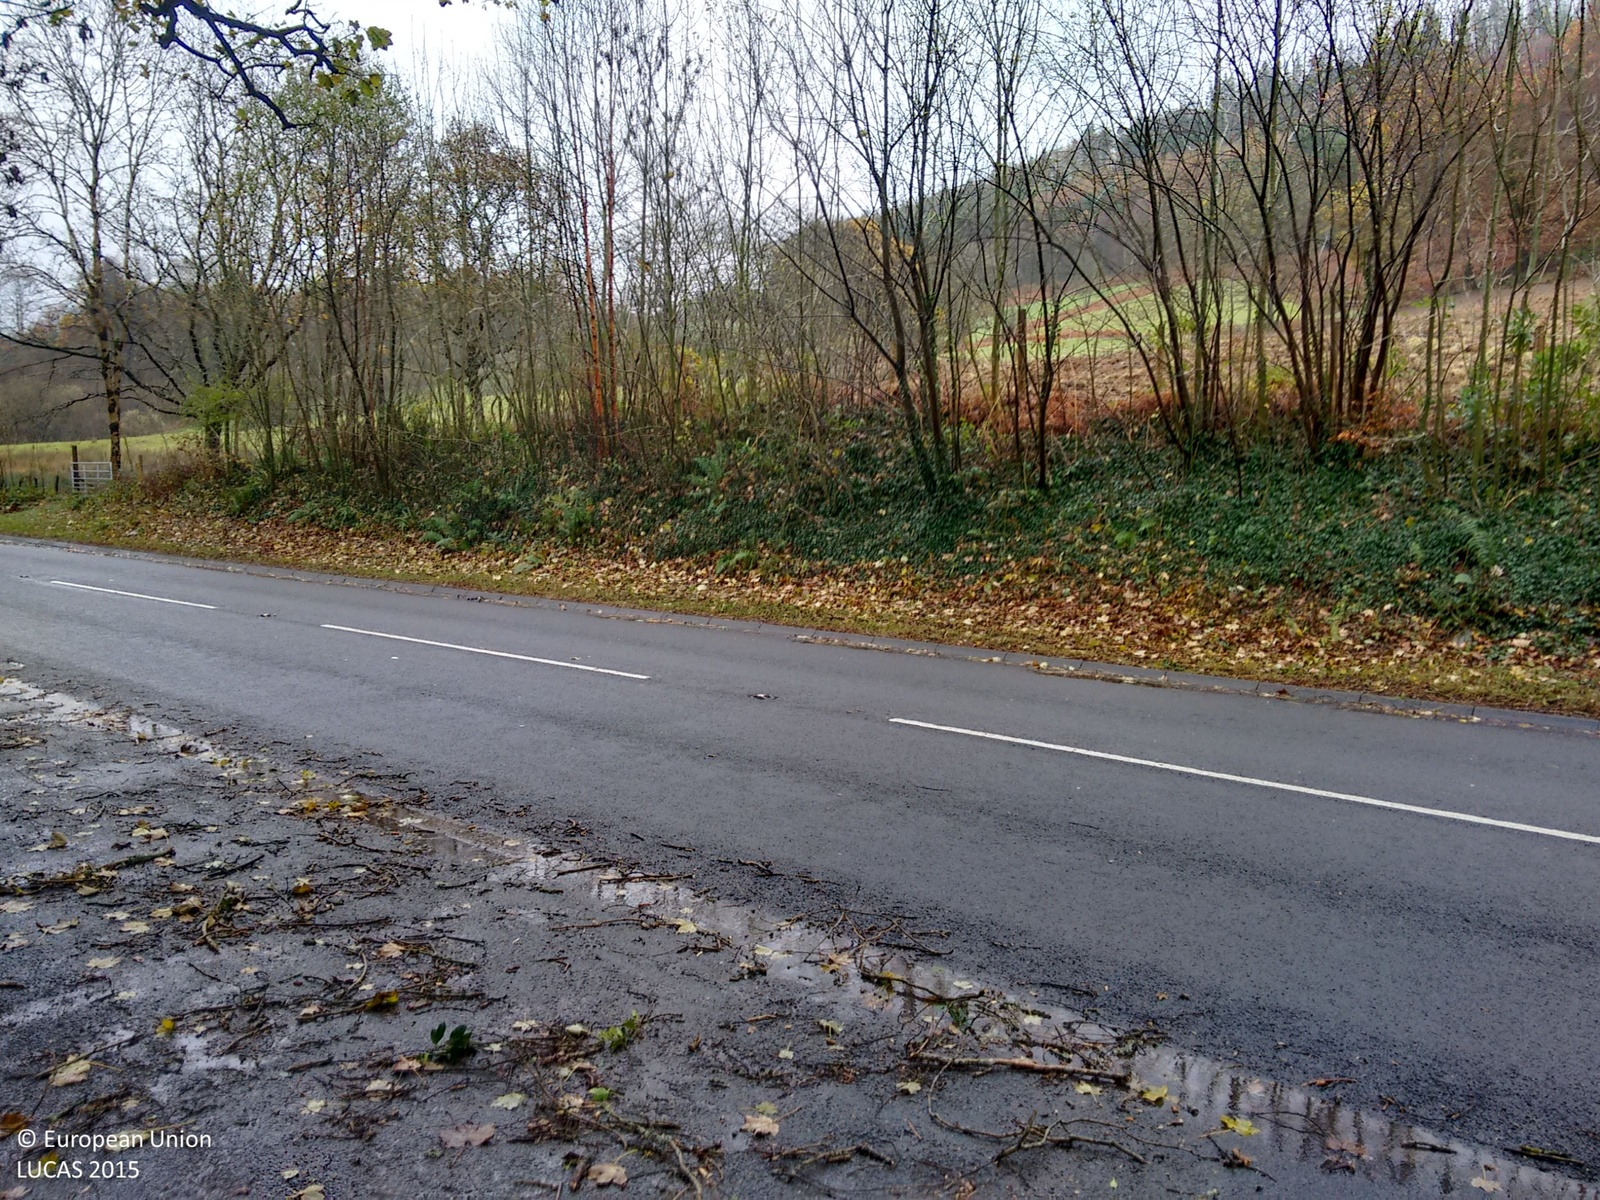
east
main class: Grassland
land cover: Grassland without tree/shrub cover
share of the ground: > 75 %
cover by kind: herbaceous plants 100 %
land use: Agriculture (excluding fallow land and kitchen gardens)
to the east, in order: Grassland without tree/shrub cover; Fences; Abandoned hedges; Grassland without tree/shrub cover; Abandoned hedges; Dry stone walls; Grassland without tree/shrub cover
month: November
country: GB
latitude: 52.9507
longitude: -3.9803
